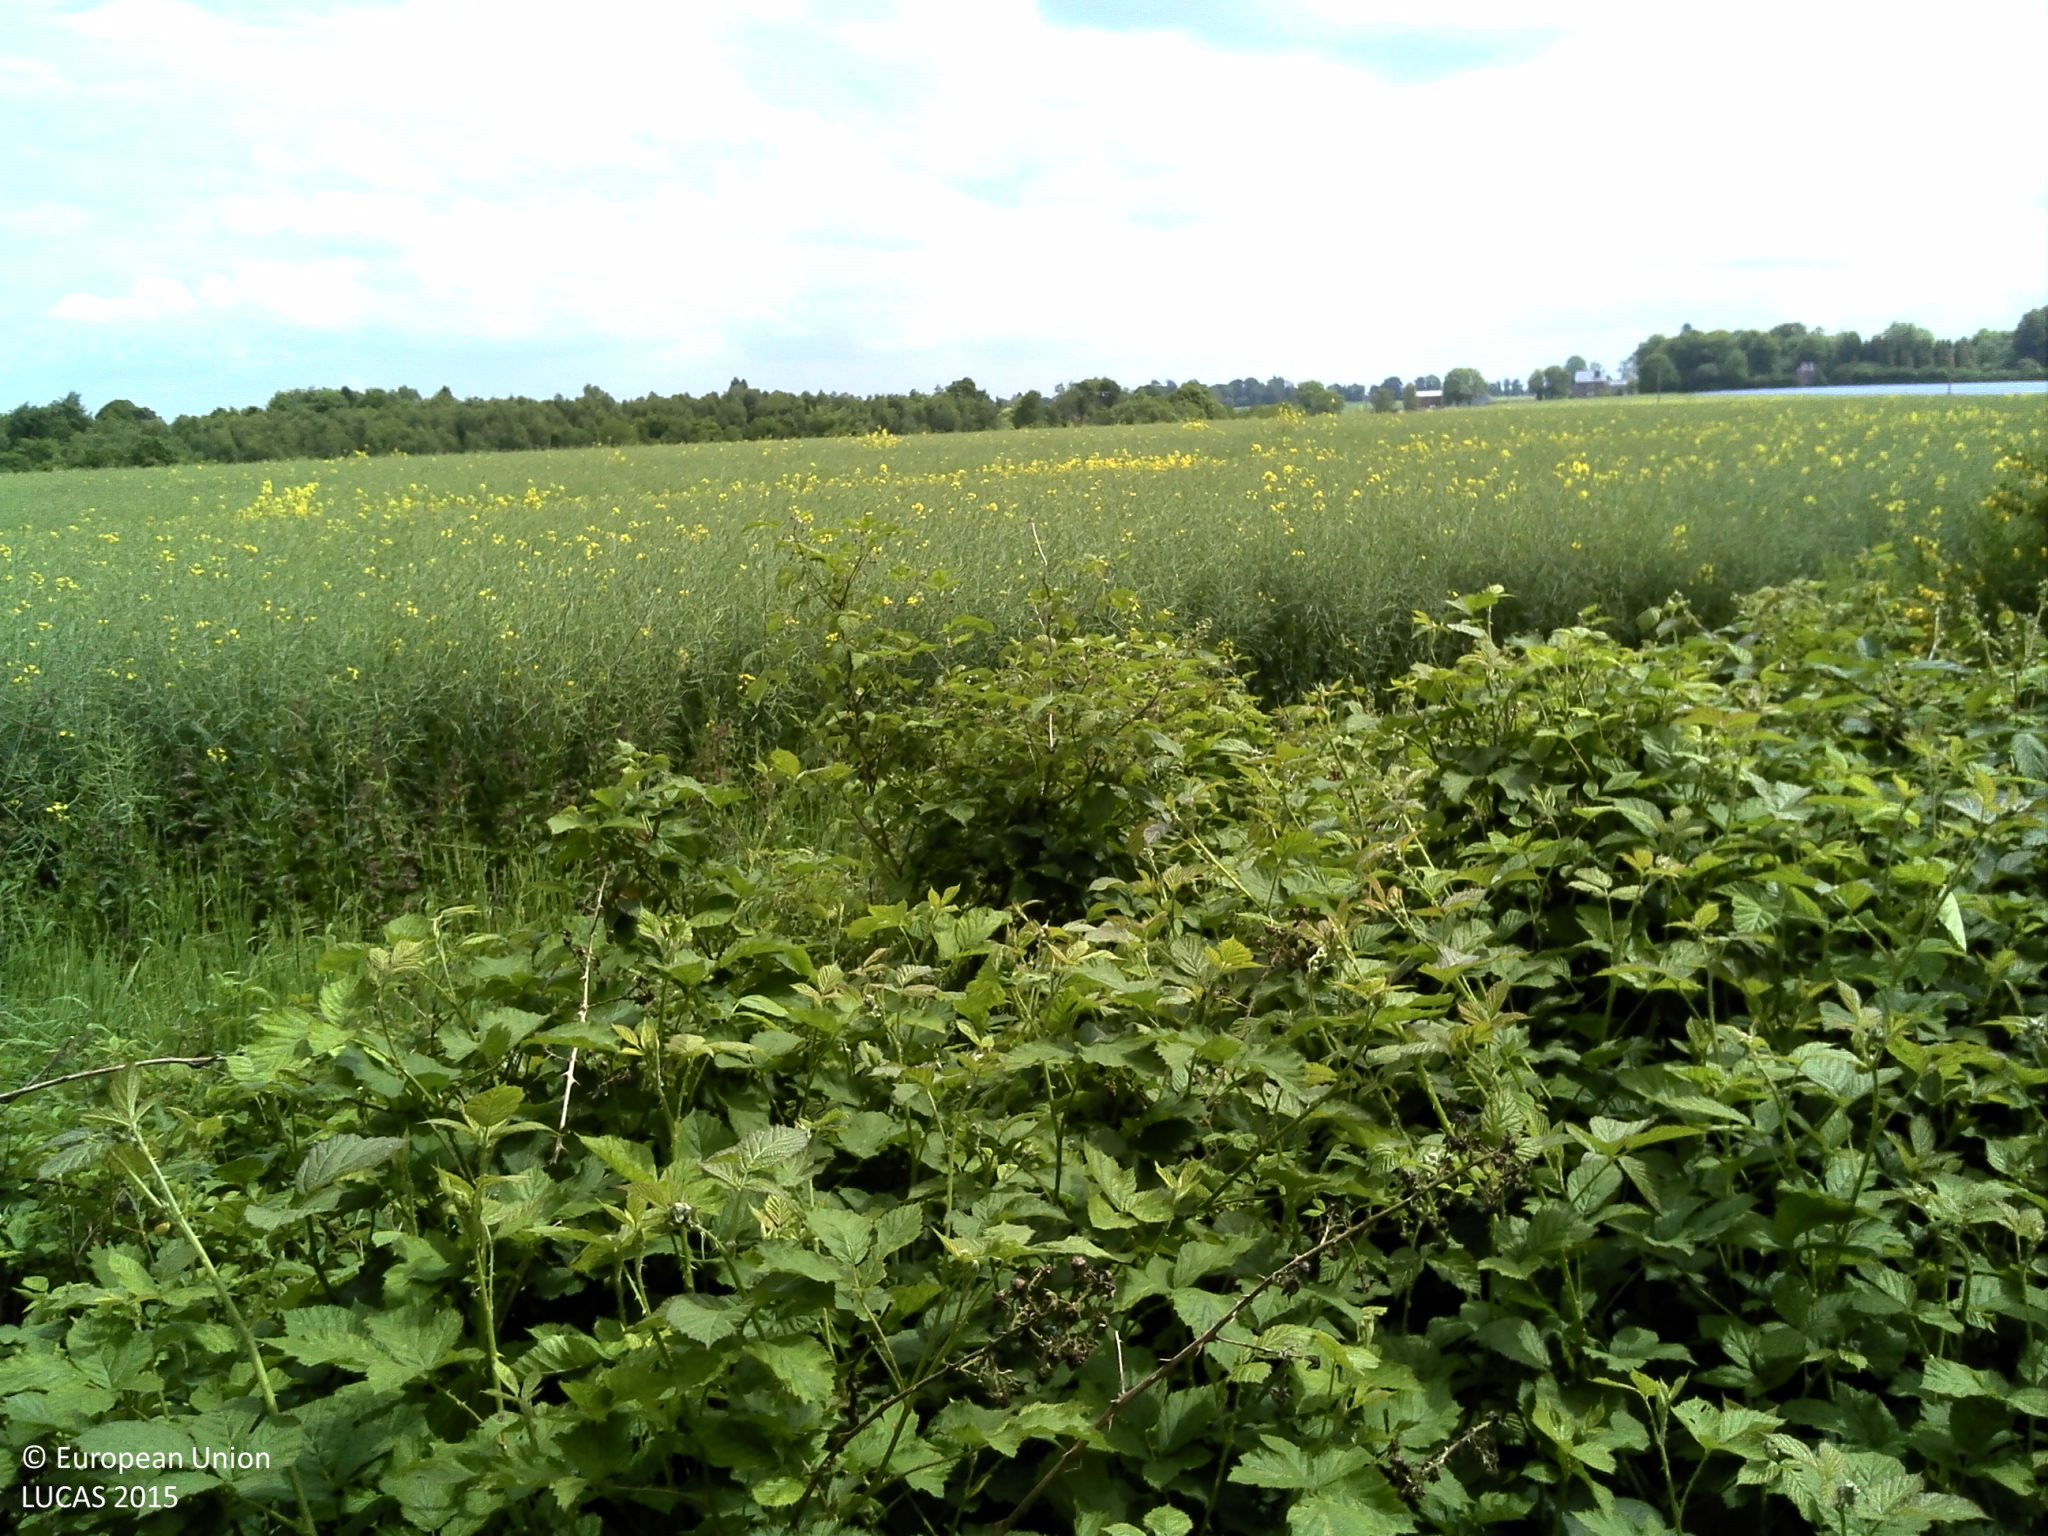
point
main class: Cropland
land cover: Rape and turnip rape
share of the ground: > 75 %
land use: Agriculture (excluding fallow land and kitchen gardens)
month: May
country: FR
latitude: 49.5541
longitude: 1.2015
